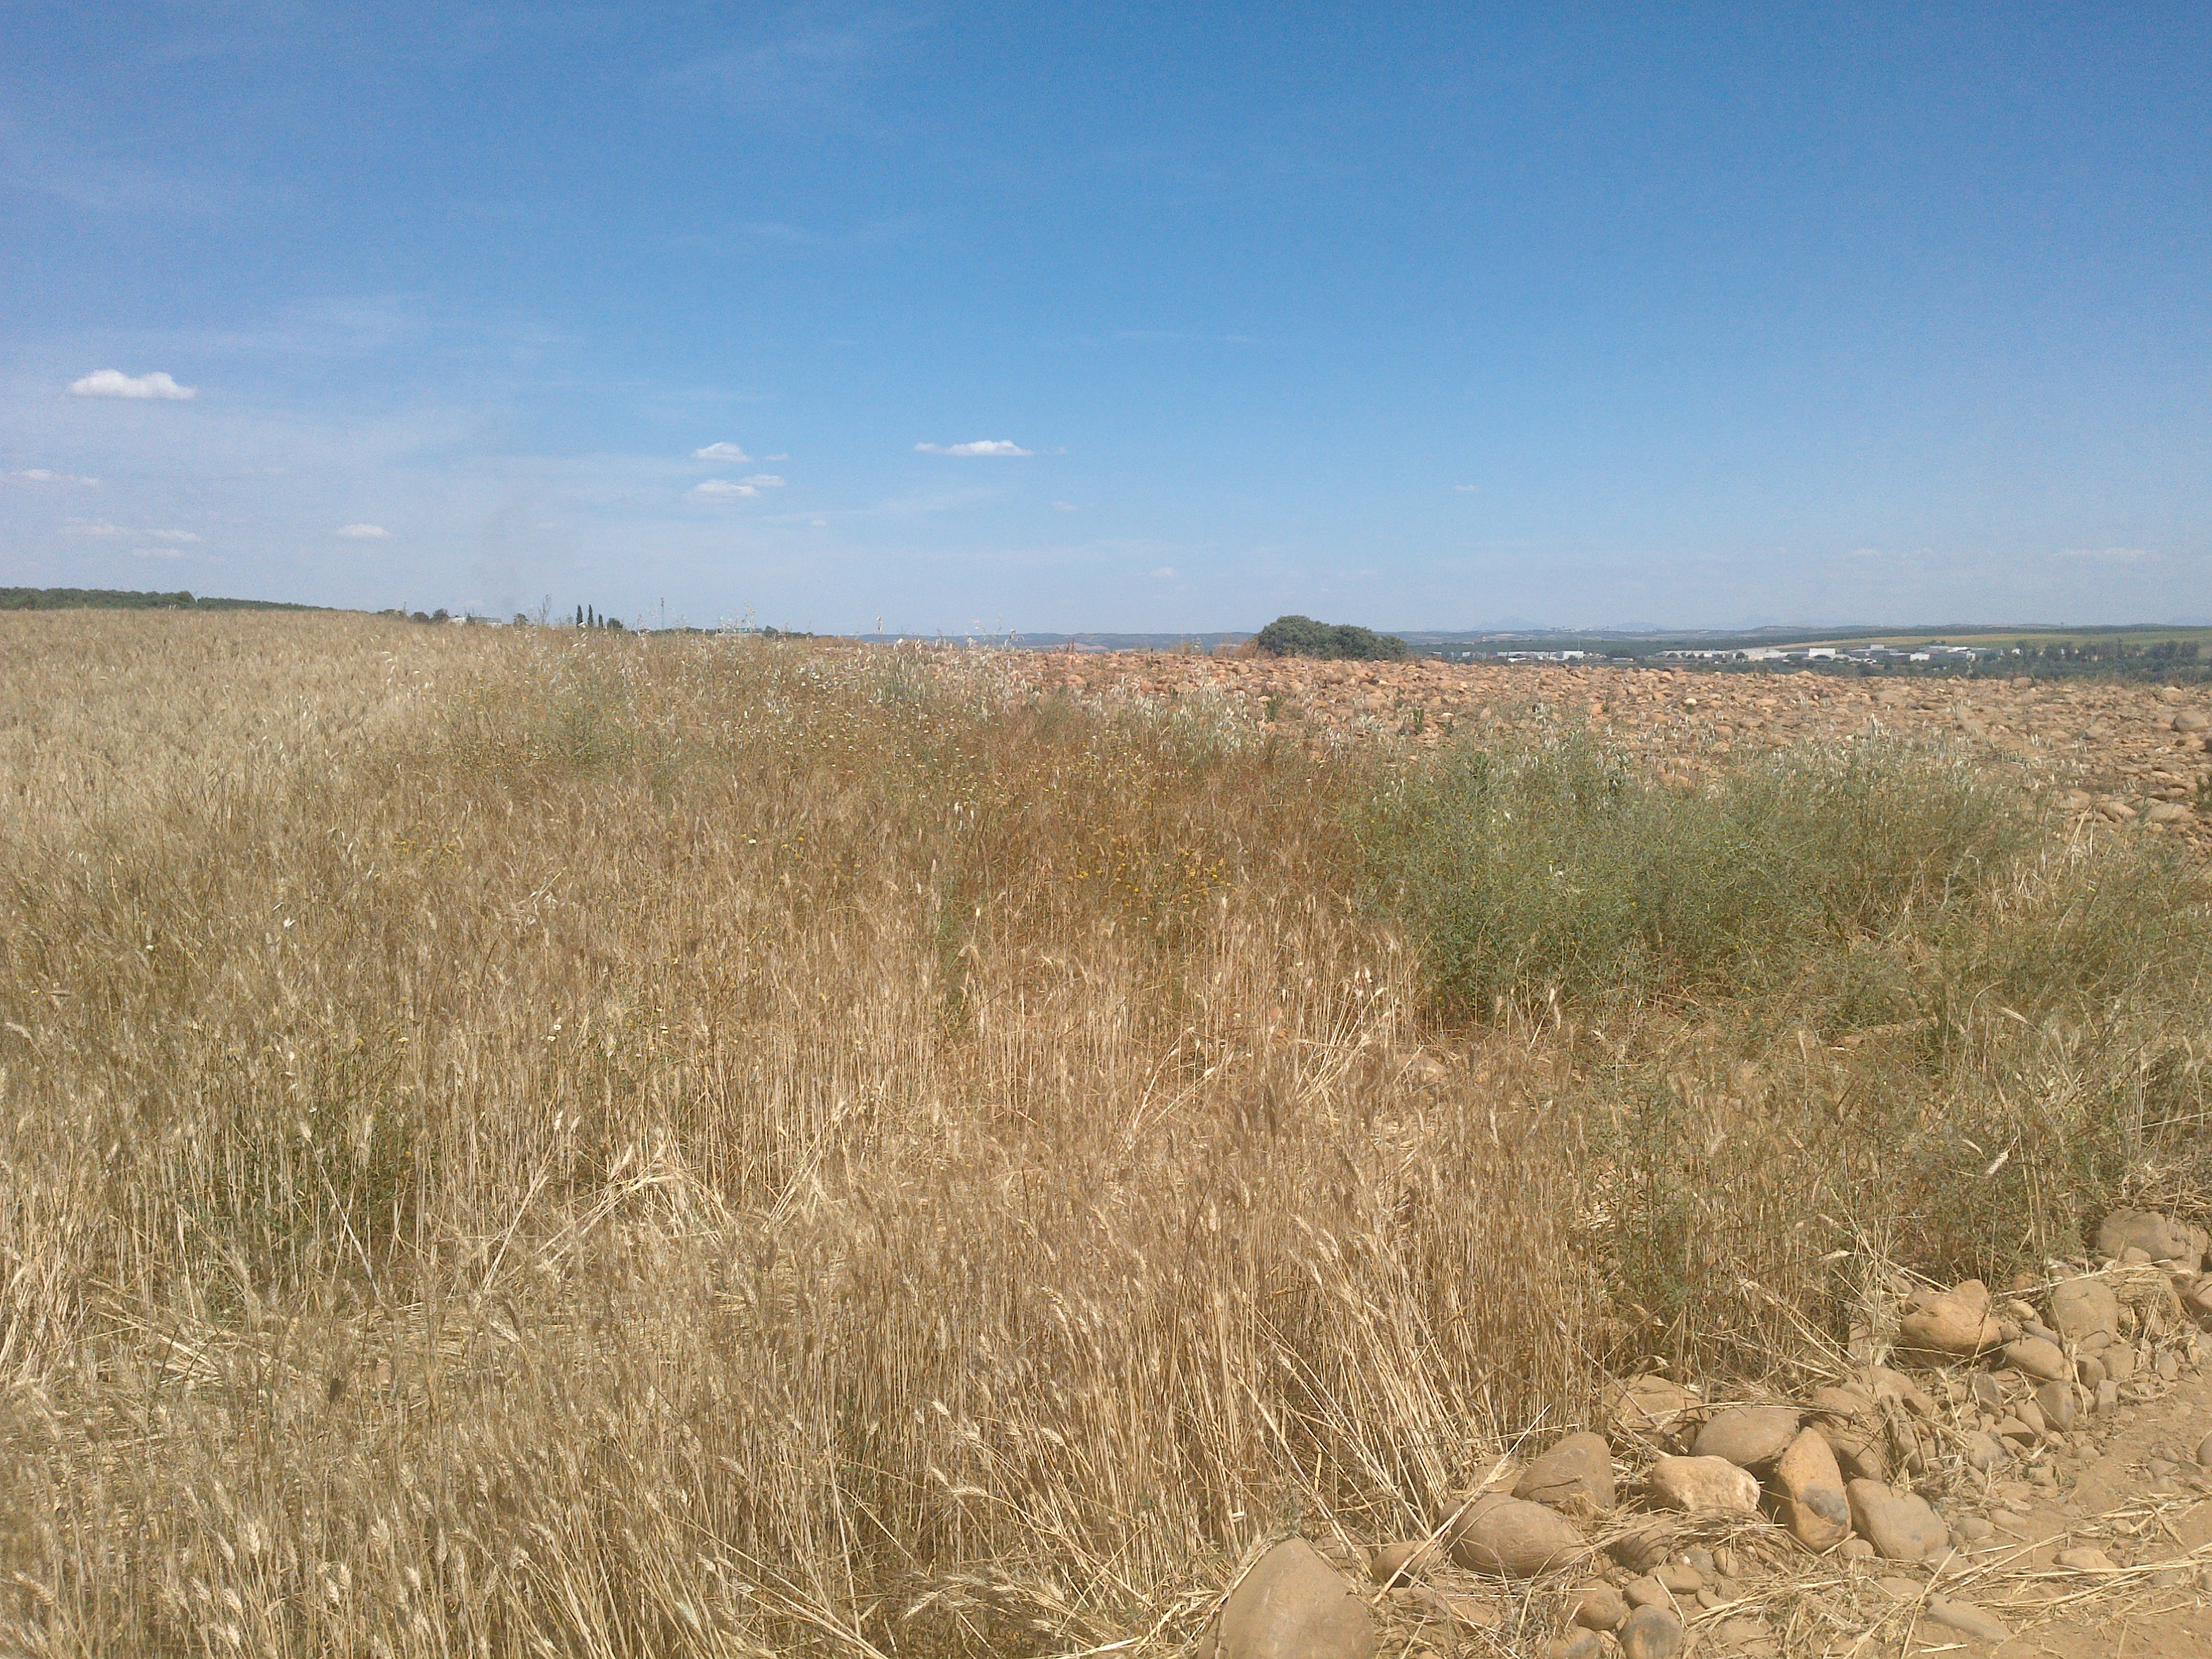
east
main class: Cropland
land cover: Olive groves
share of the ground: 50 - 75 %
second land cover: Spontaneously vegetated surfaces
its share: 25 - 50 %
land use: Agriculture (excluding fallow land and kitchen gardens)
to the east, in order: Olive groves; Spontaneously vegetated surfaces; Fences; Spontaneously vegetated surfaces; Sunflower
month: May
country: ES
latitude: 37.9610
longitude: -4.5704
